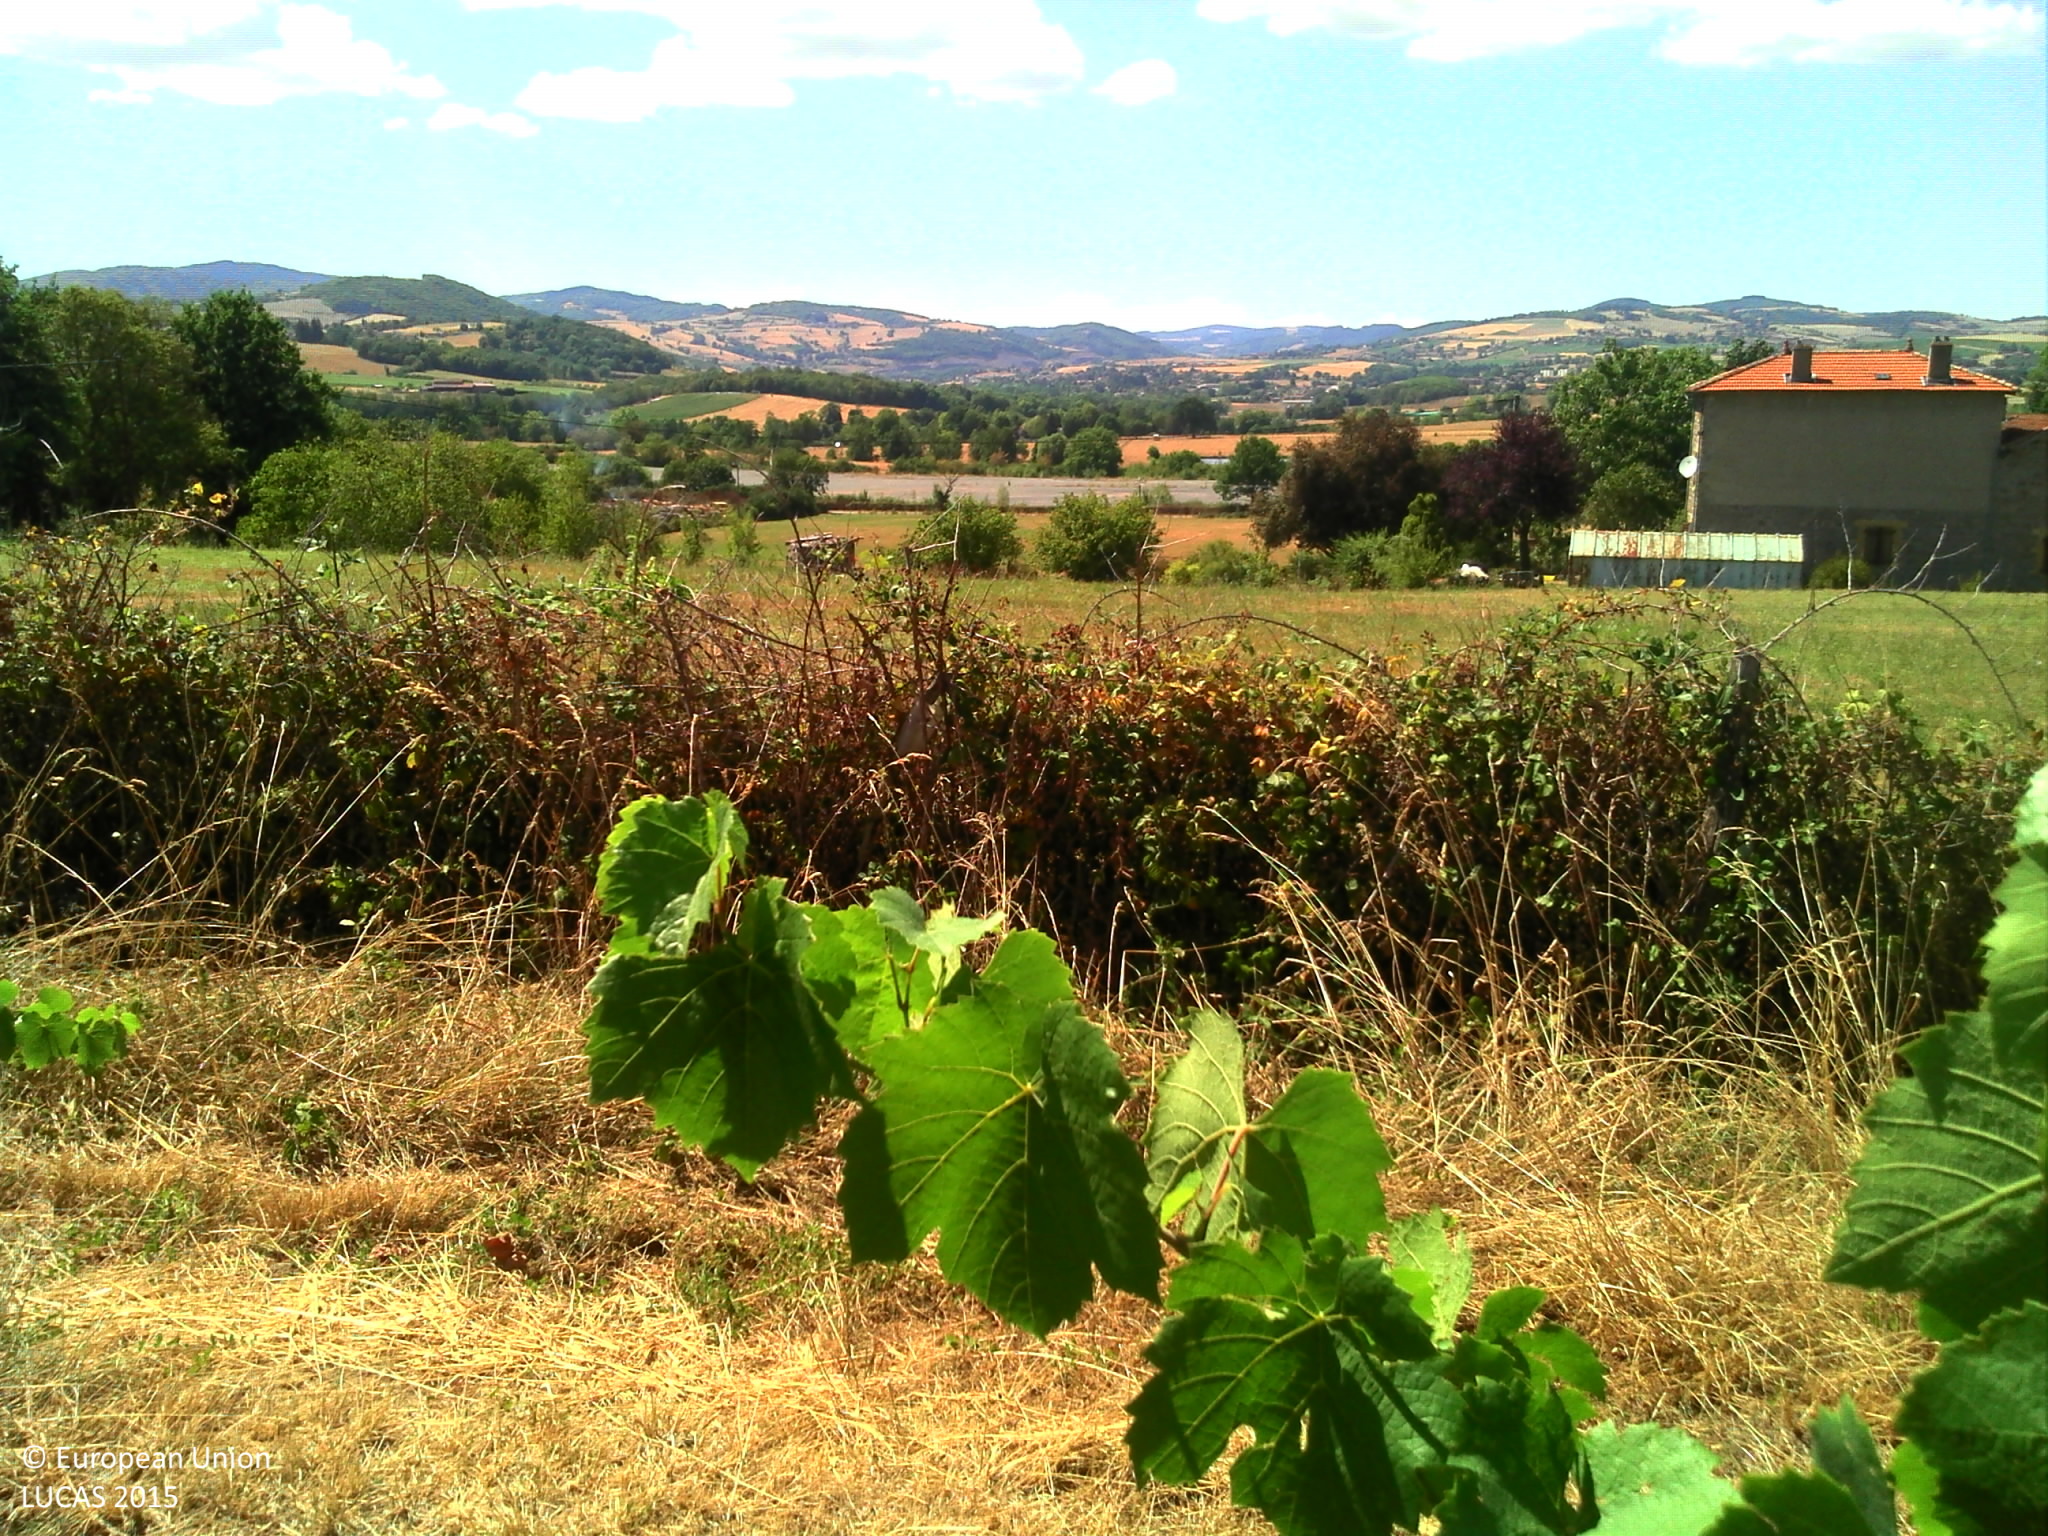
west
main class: Cropland
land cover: Vineyards
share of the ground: 50 - 75 %
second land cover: Other bare soil
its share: > 75 %
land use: Agriculture (excluding fallow land and kitchen gardens)
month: July
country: FR
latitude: 45.8695
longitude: 4.5538
